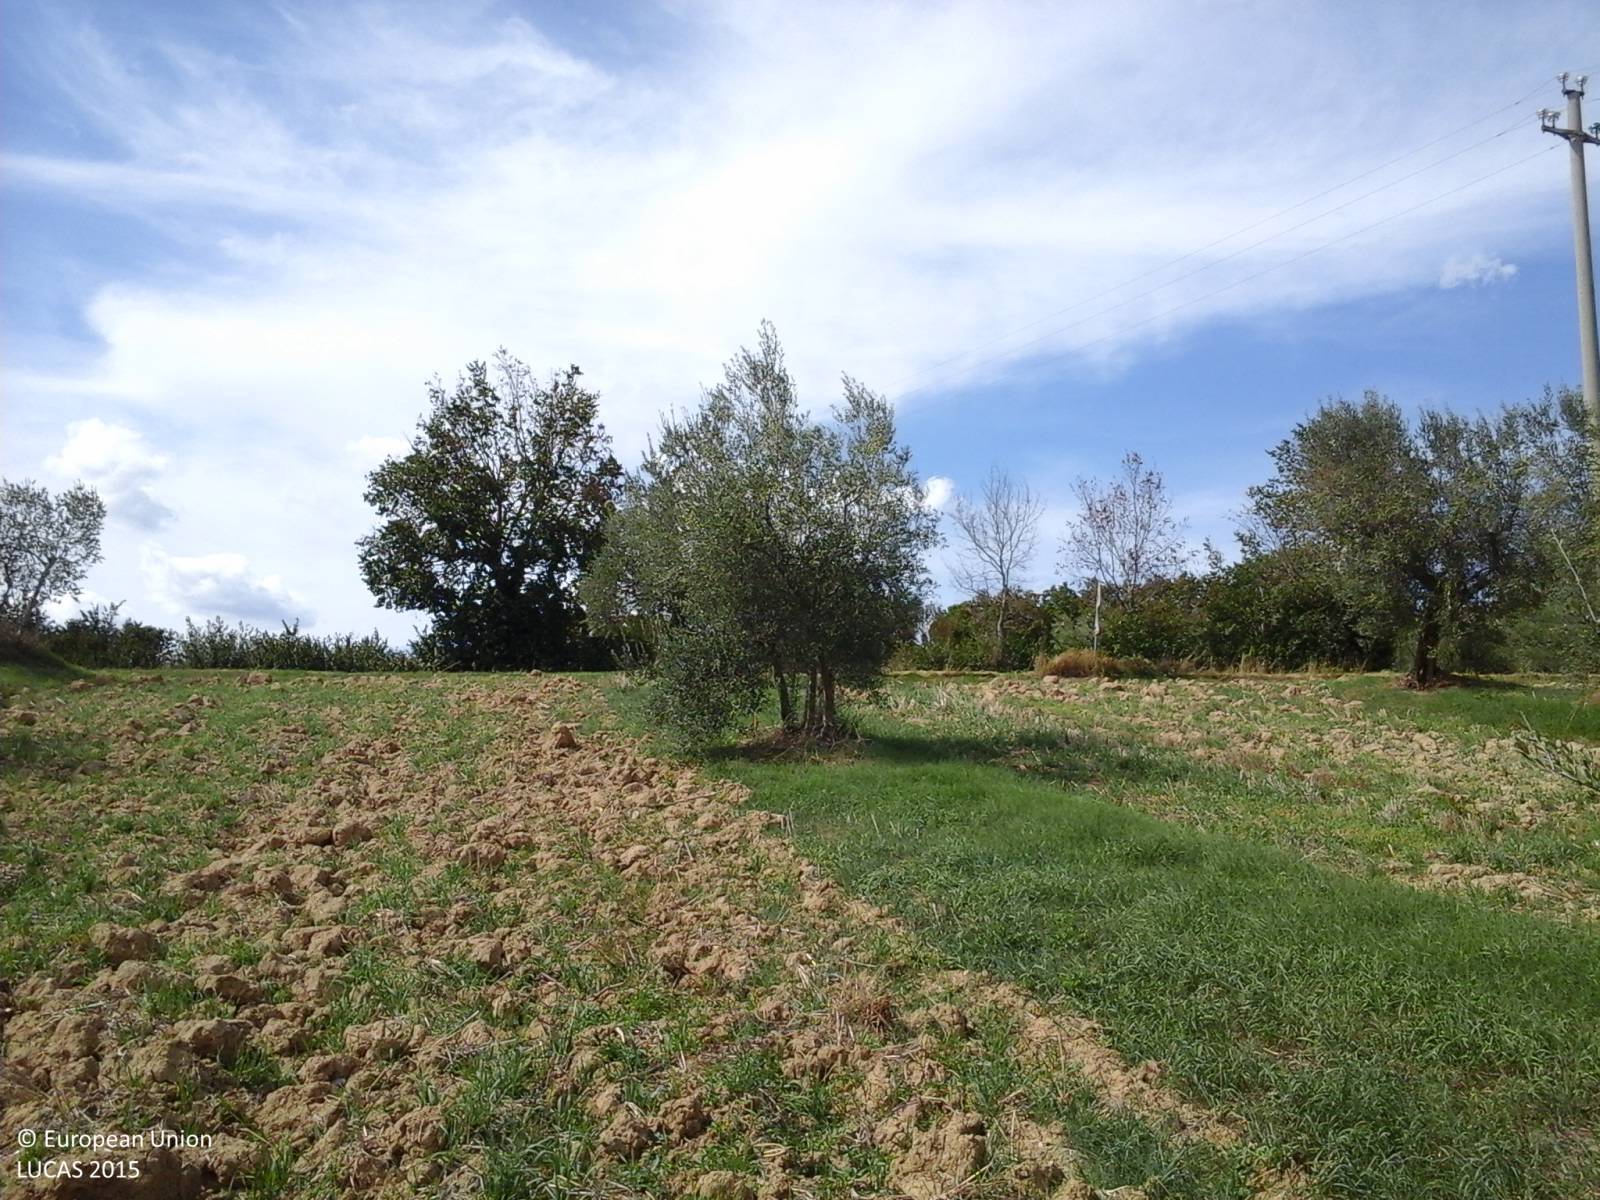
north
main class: Cropland
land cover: Olive groves
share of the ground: 10 - 25 %
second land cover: Other bare soil
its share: > 75 %
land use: Agriculture (excluding fallow land and kitchen gardens)
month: September
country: IT
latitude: 43.0239
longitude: 12.3614
